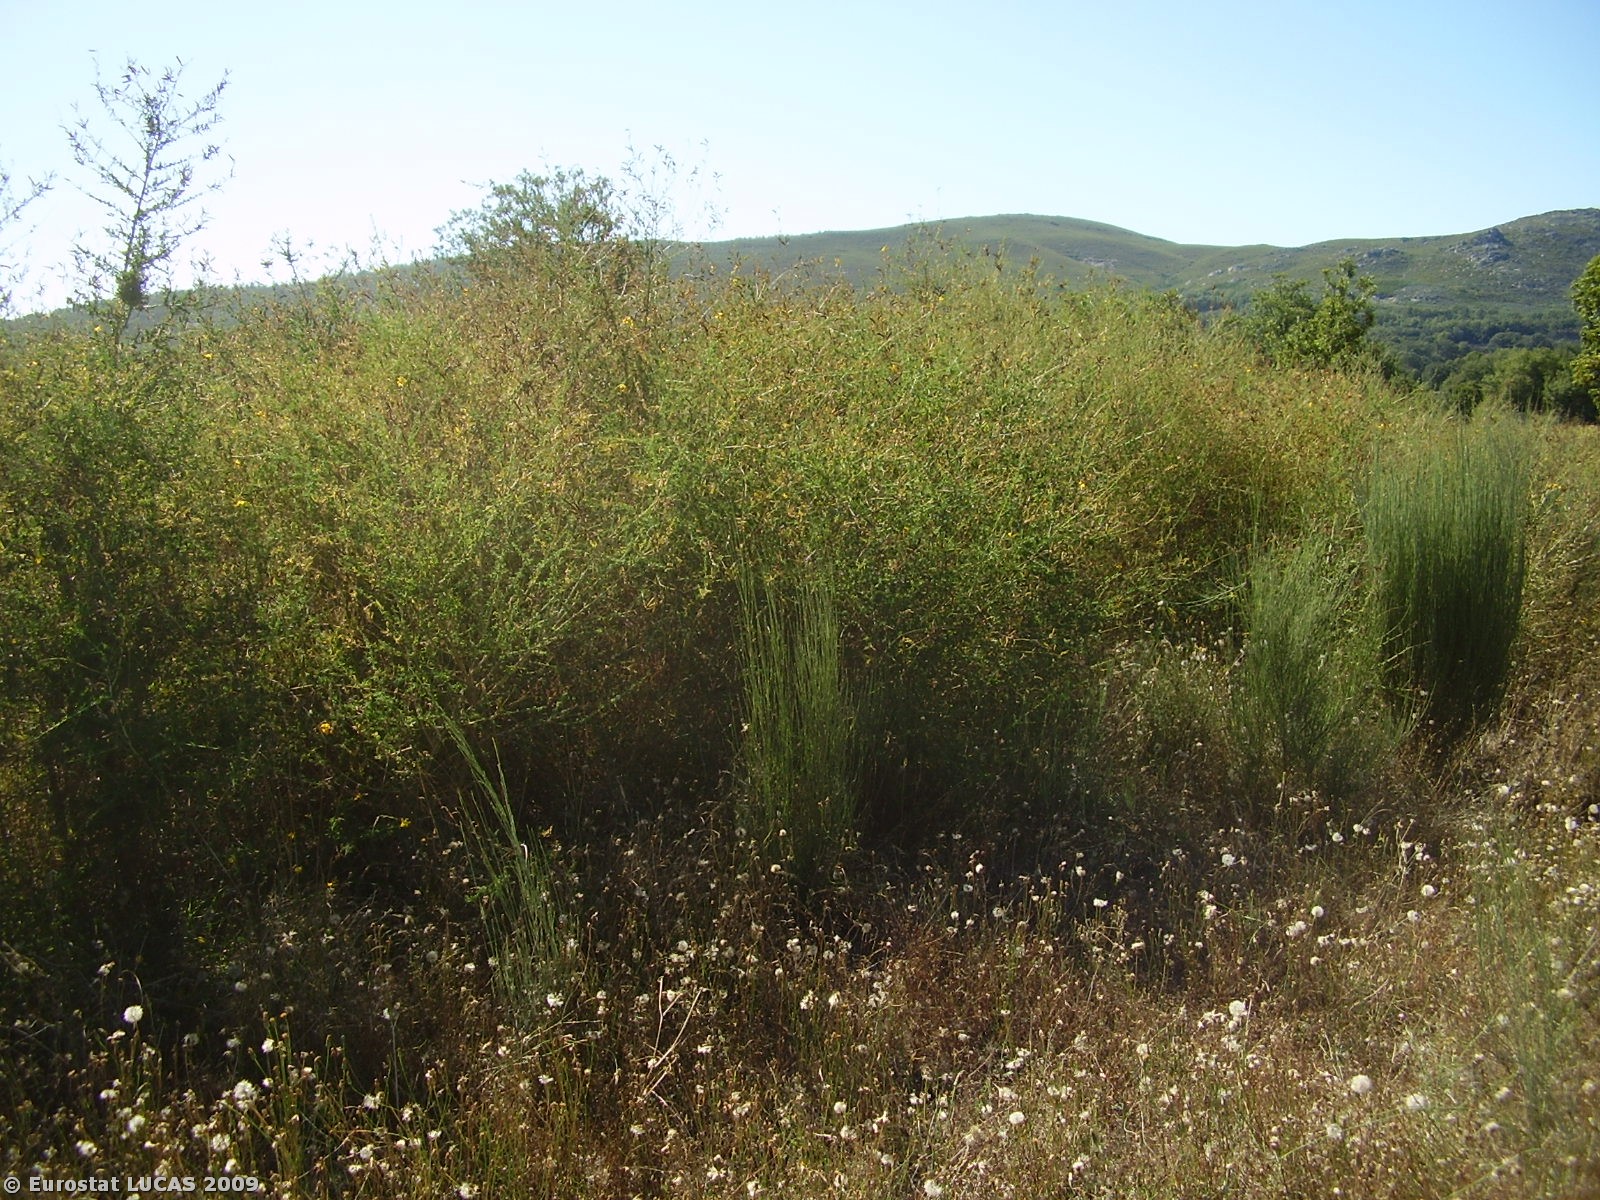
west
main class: Grassland
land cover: Spontaneously vegetated surfaces
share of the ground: > 75 %
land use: Fallow land
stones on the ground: 10 - 25 %
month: September
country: PT
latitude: 41.8089
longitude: -7.6496
